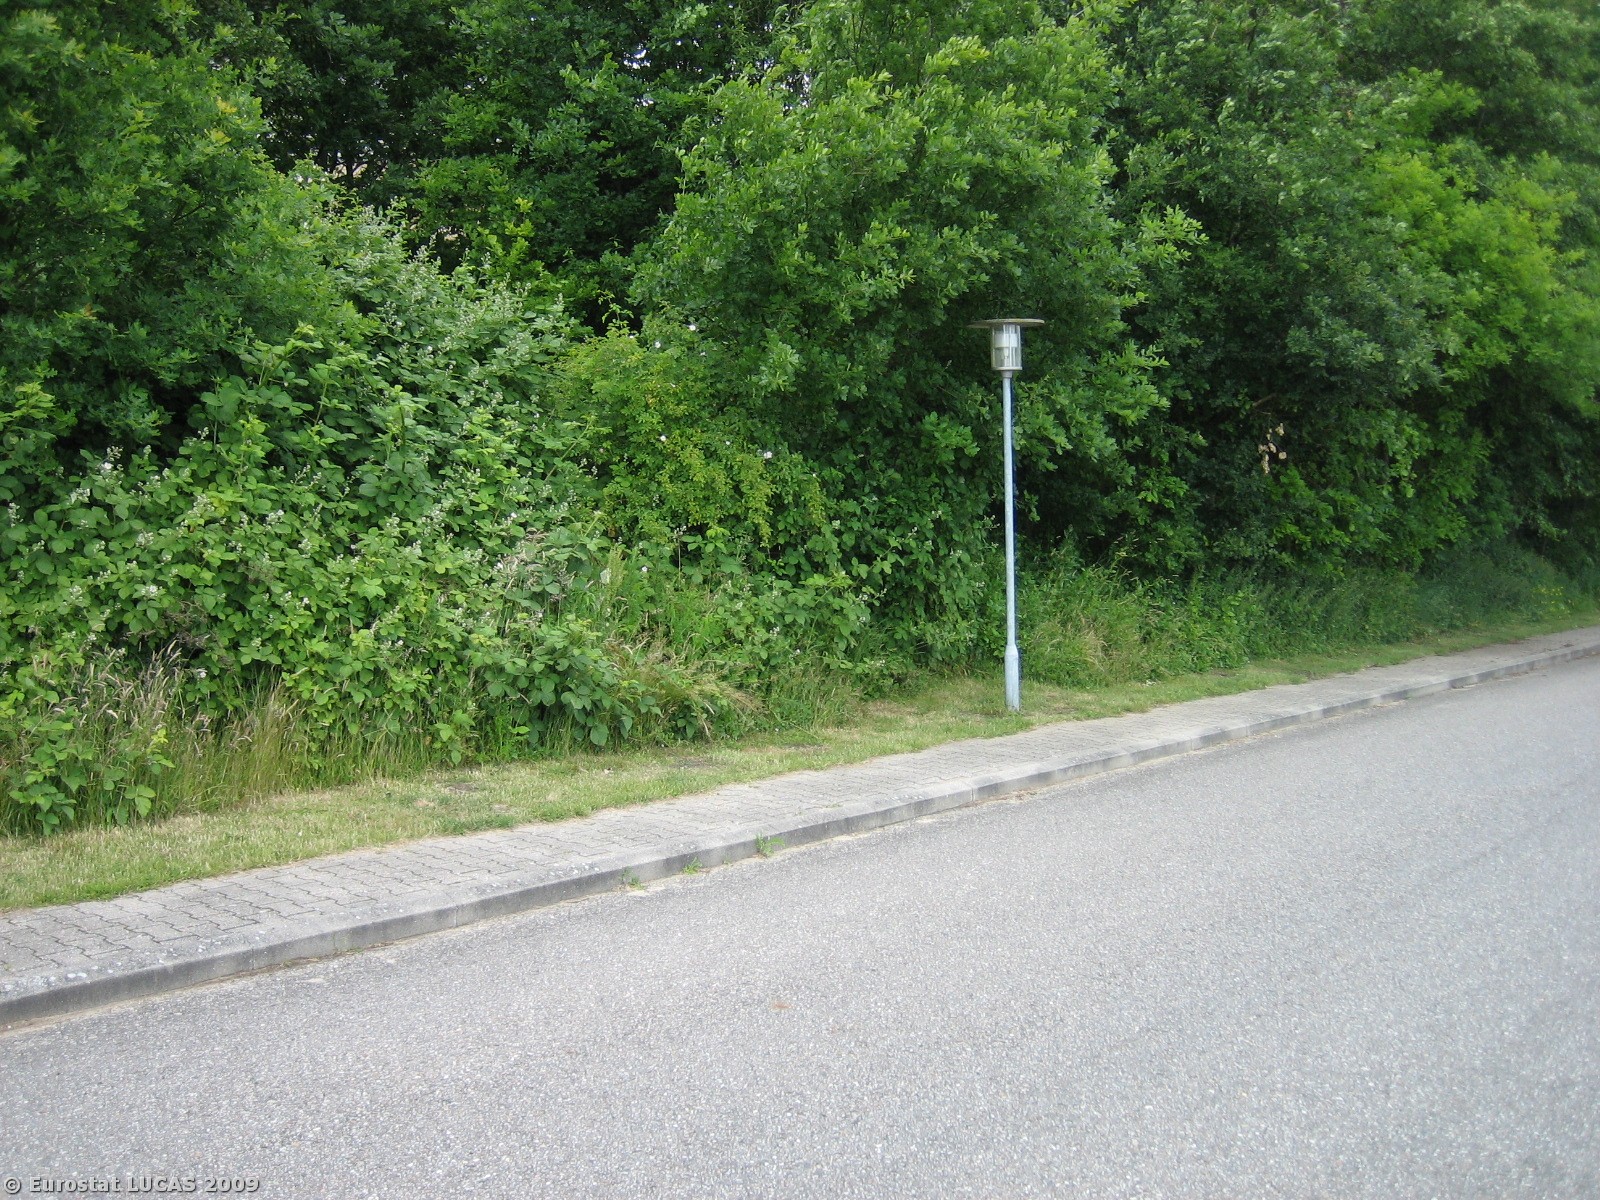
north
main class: Grassland
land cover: Grassland without tree/shrub cover
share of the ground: > 75 %
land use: Amenities, museums, leisure
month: June
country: DK
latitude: 55.5763
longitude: 9.7306
